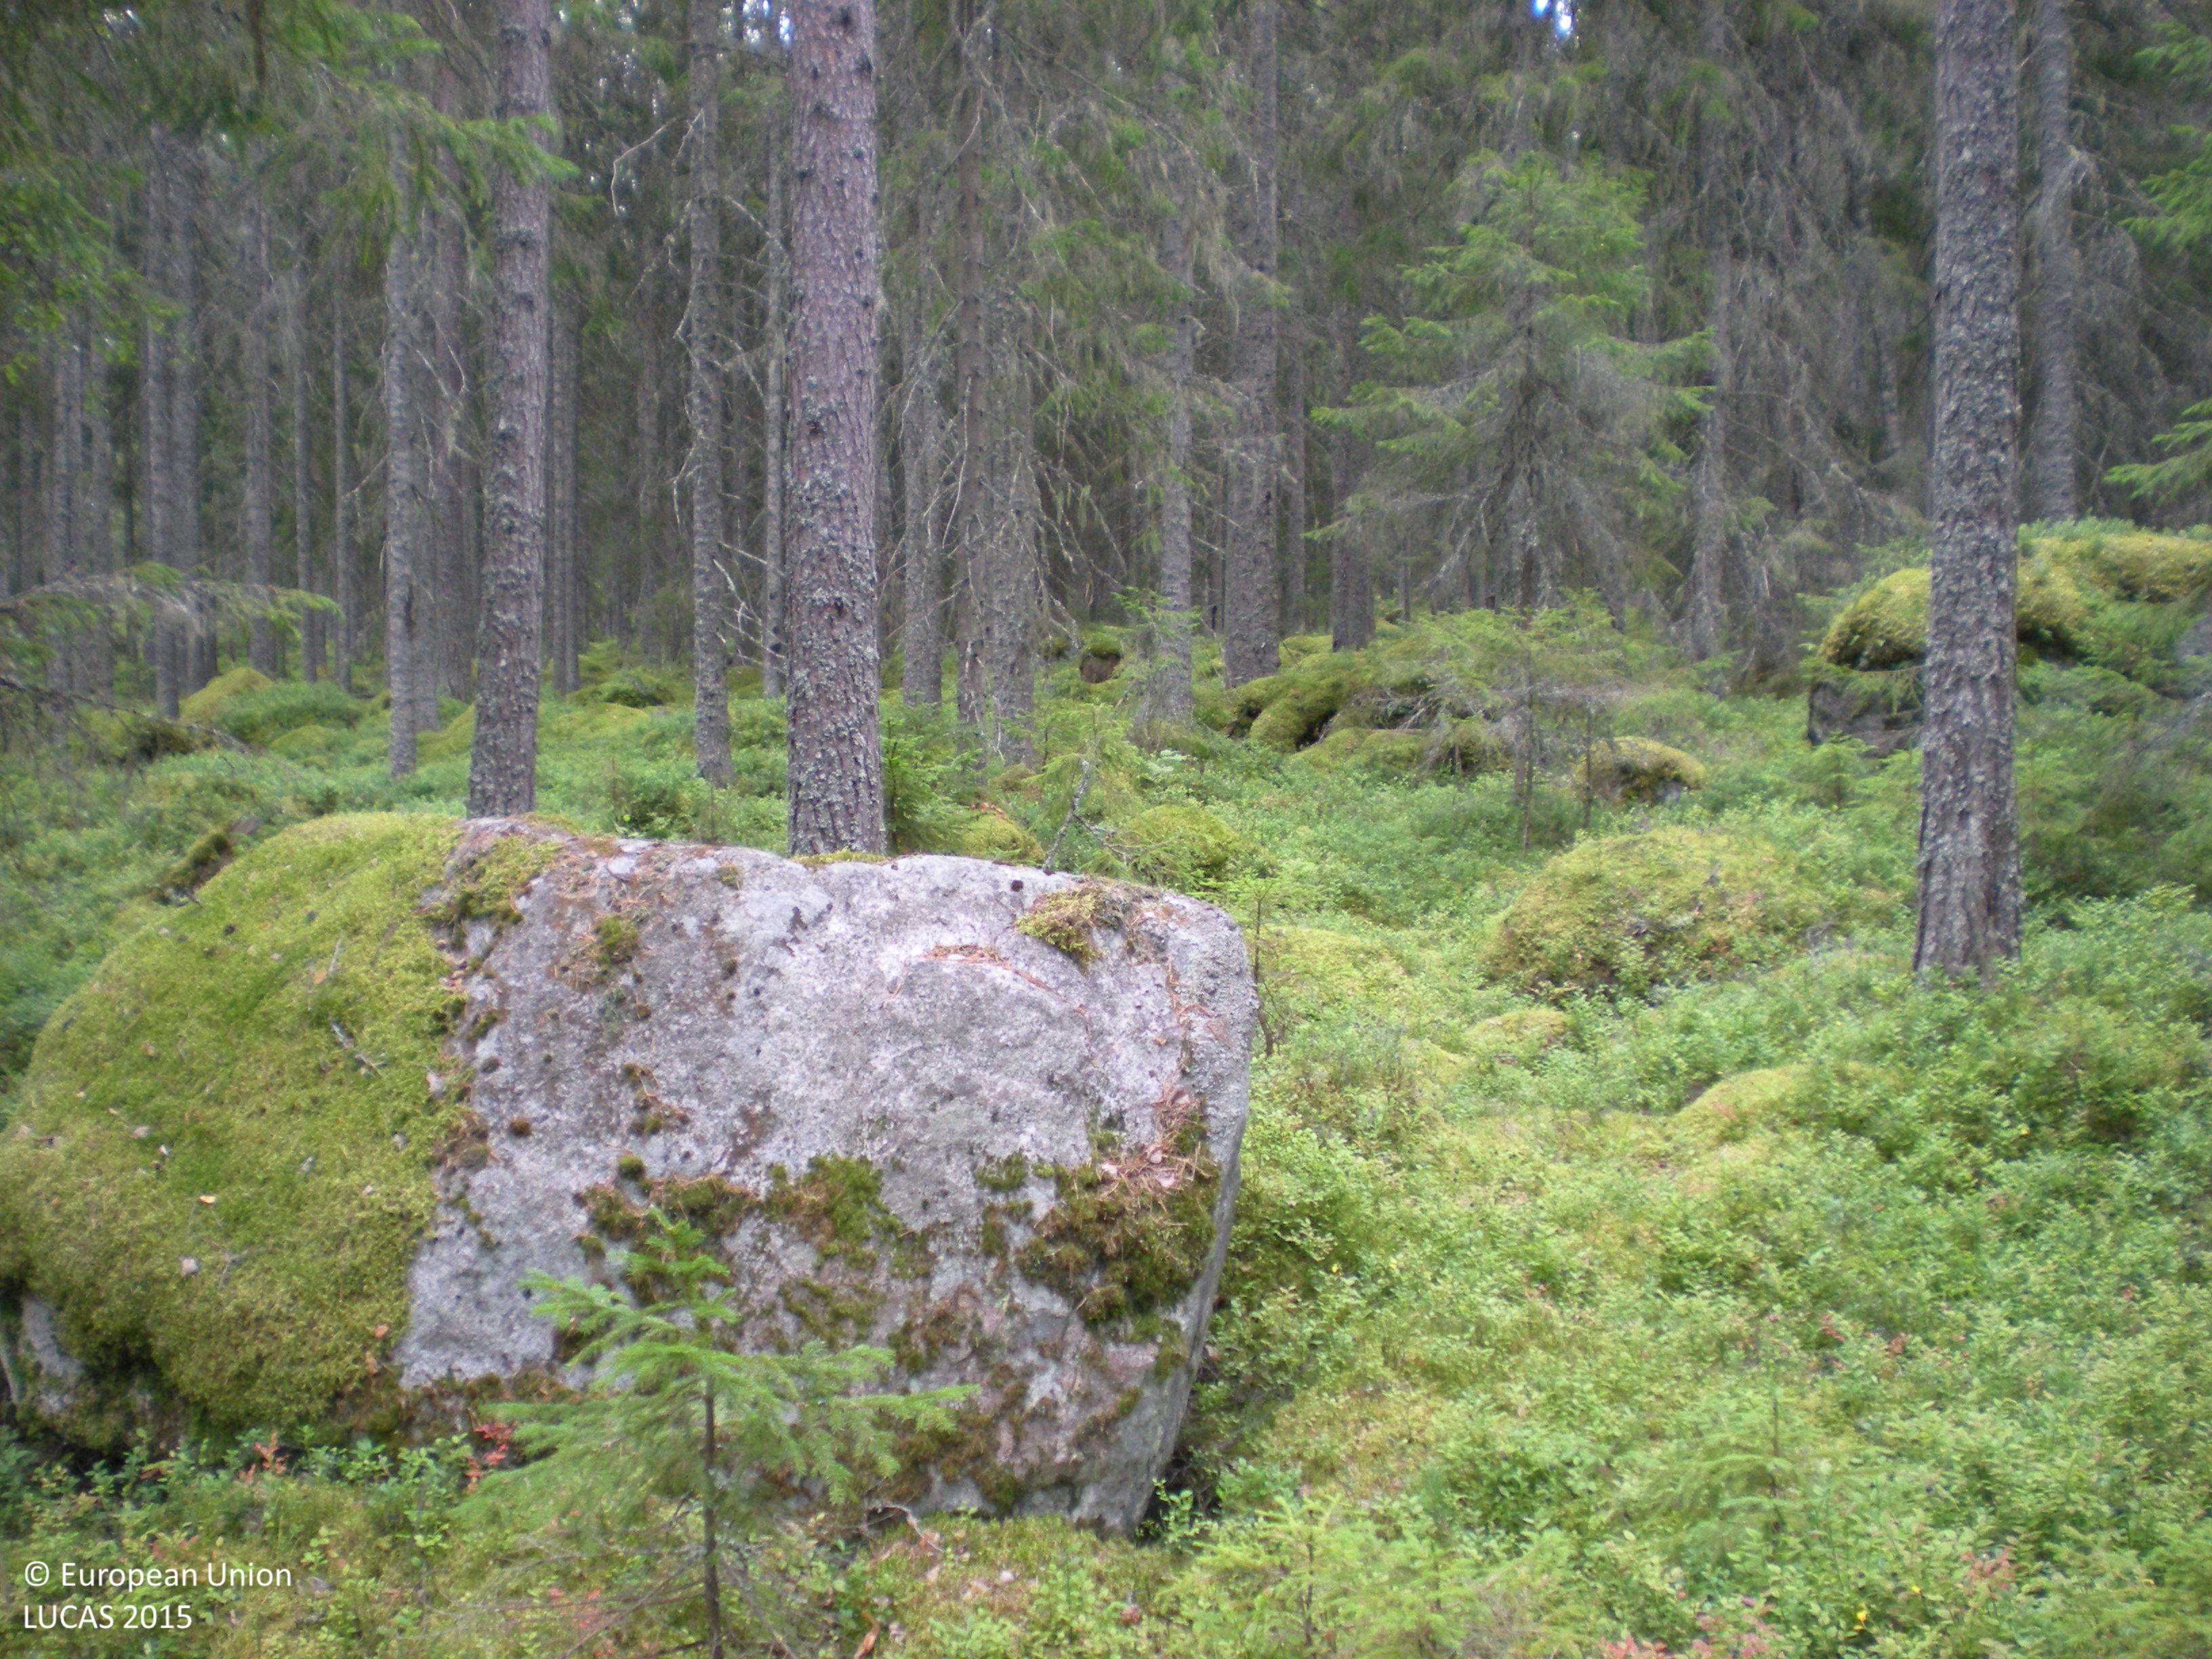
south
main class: Woodland
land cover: Other coniferous woodland
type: boreal forest
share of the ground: 50 - 75 %
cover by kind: coniferous forest trees 65 %, shrubs 15 %, lichens and mosses 10 %, herbaceous plants 5 %, consolidated bare surface 5 %
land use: Forestry
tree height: > 5 m
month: August
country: SE
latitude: 60.8477
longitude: 17.1838
